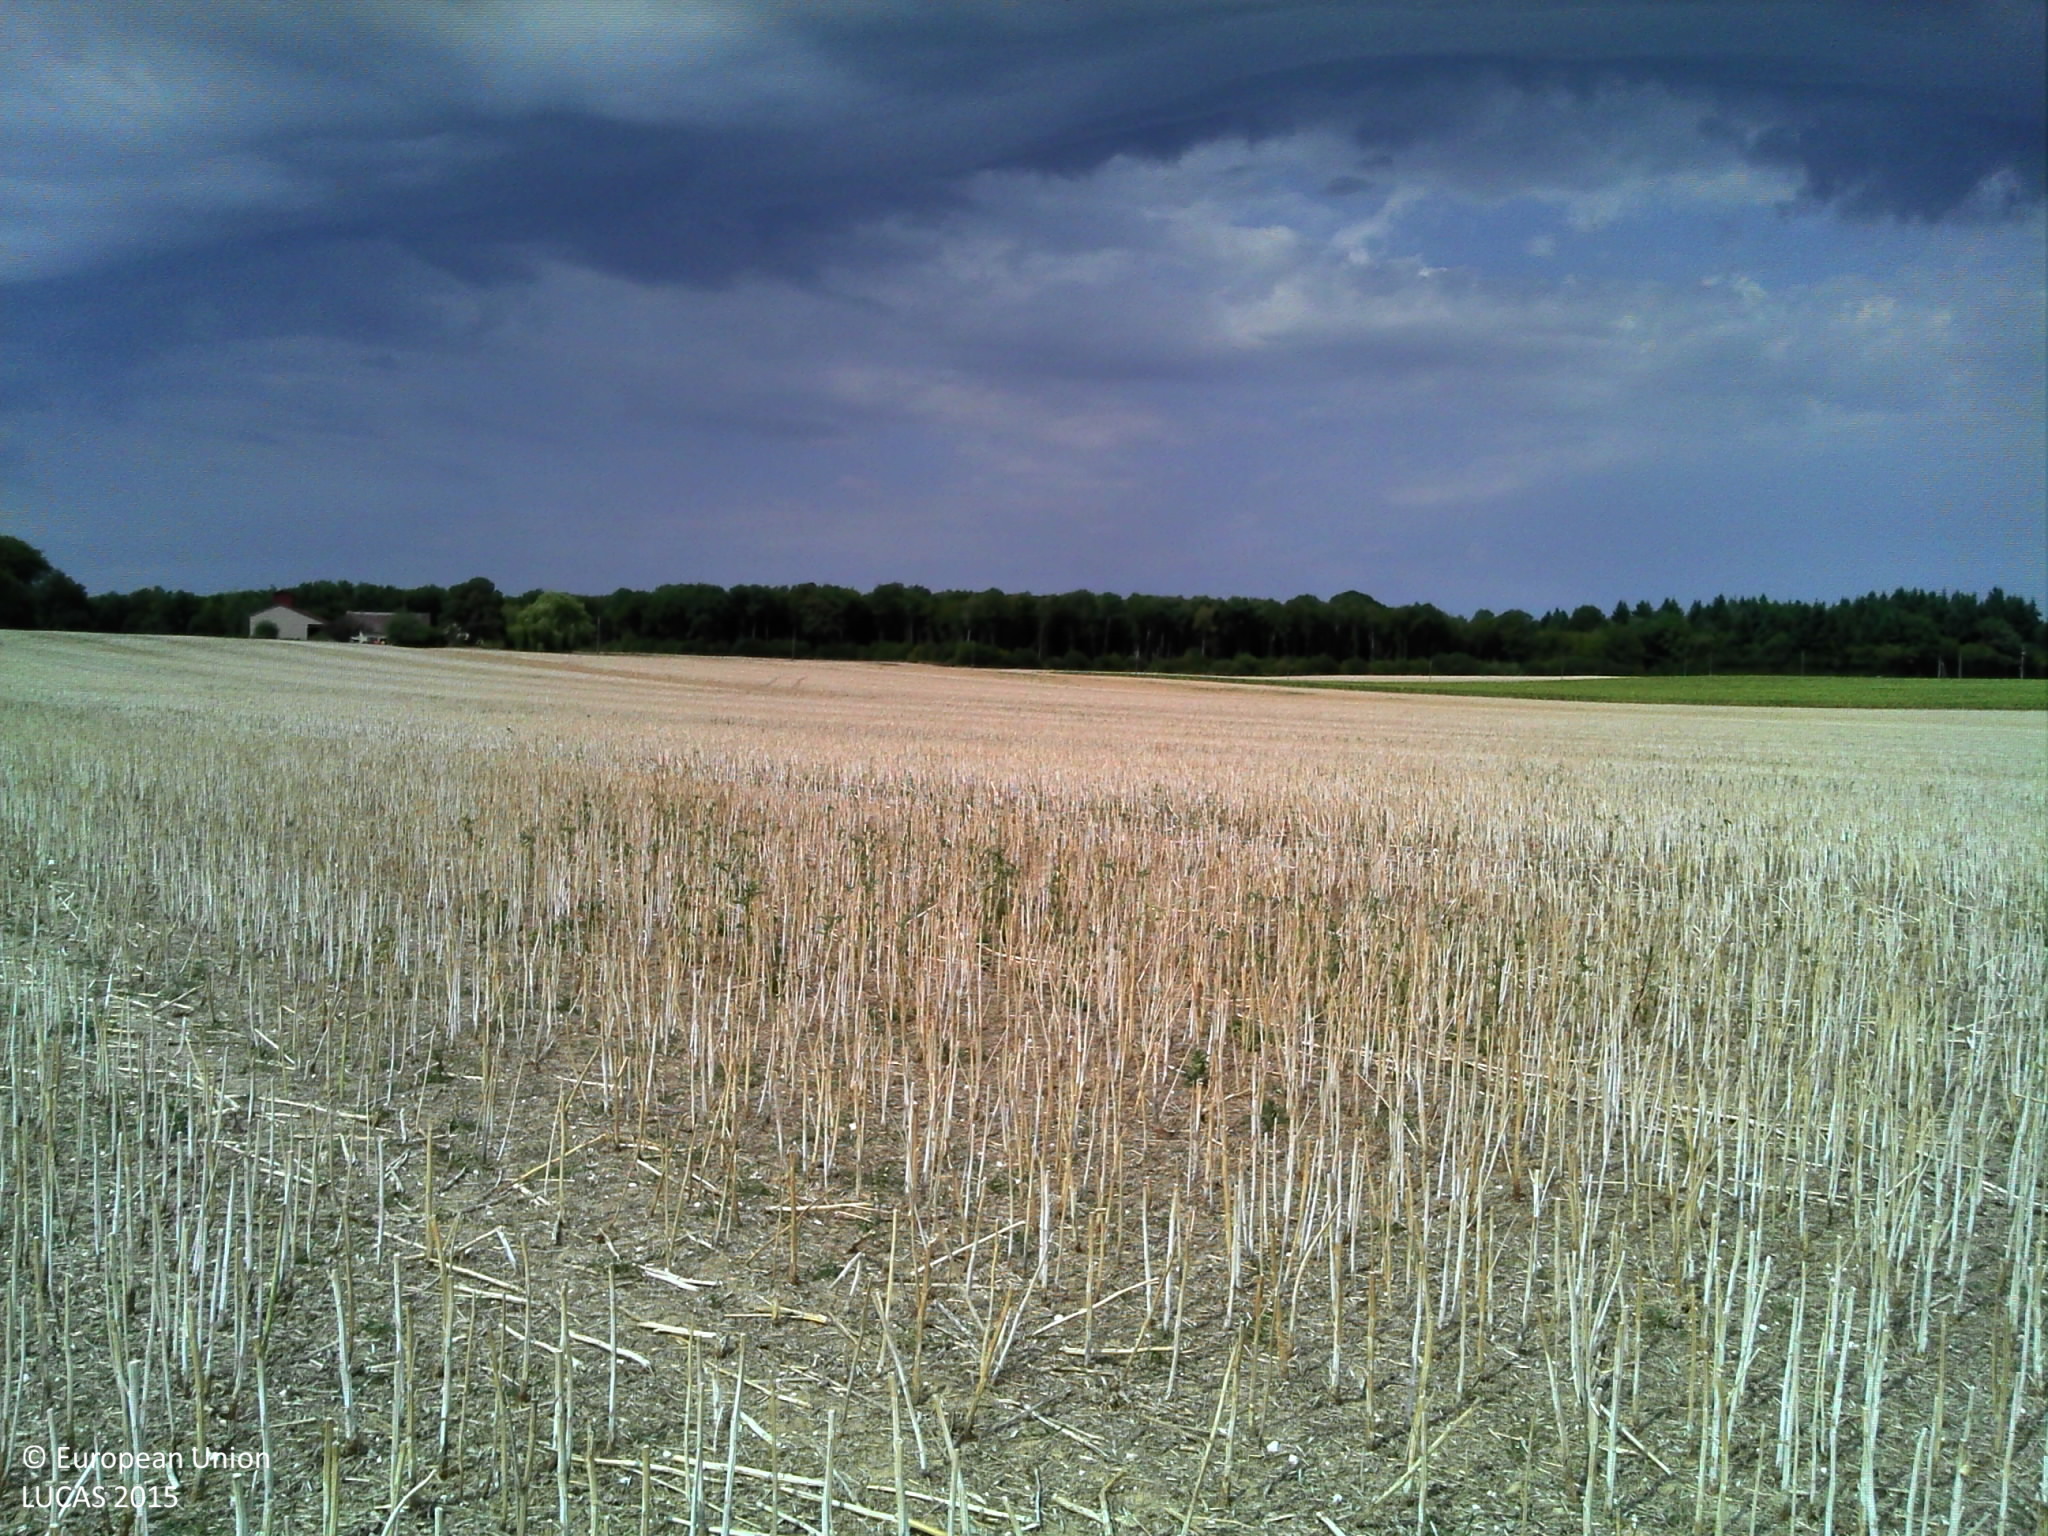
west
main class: Cropland
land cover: Rape and turnip rape
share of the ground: > 75 %
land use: Agriculture (excluding fallow land and kitchen gardens)
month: August
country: FR
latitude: 47.7201
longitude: 3.1288
